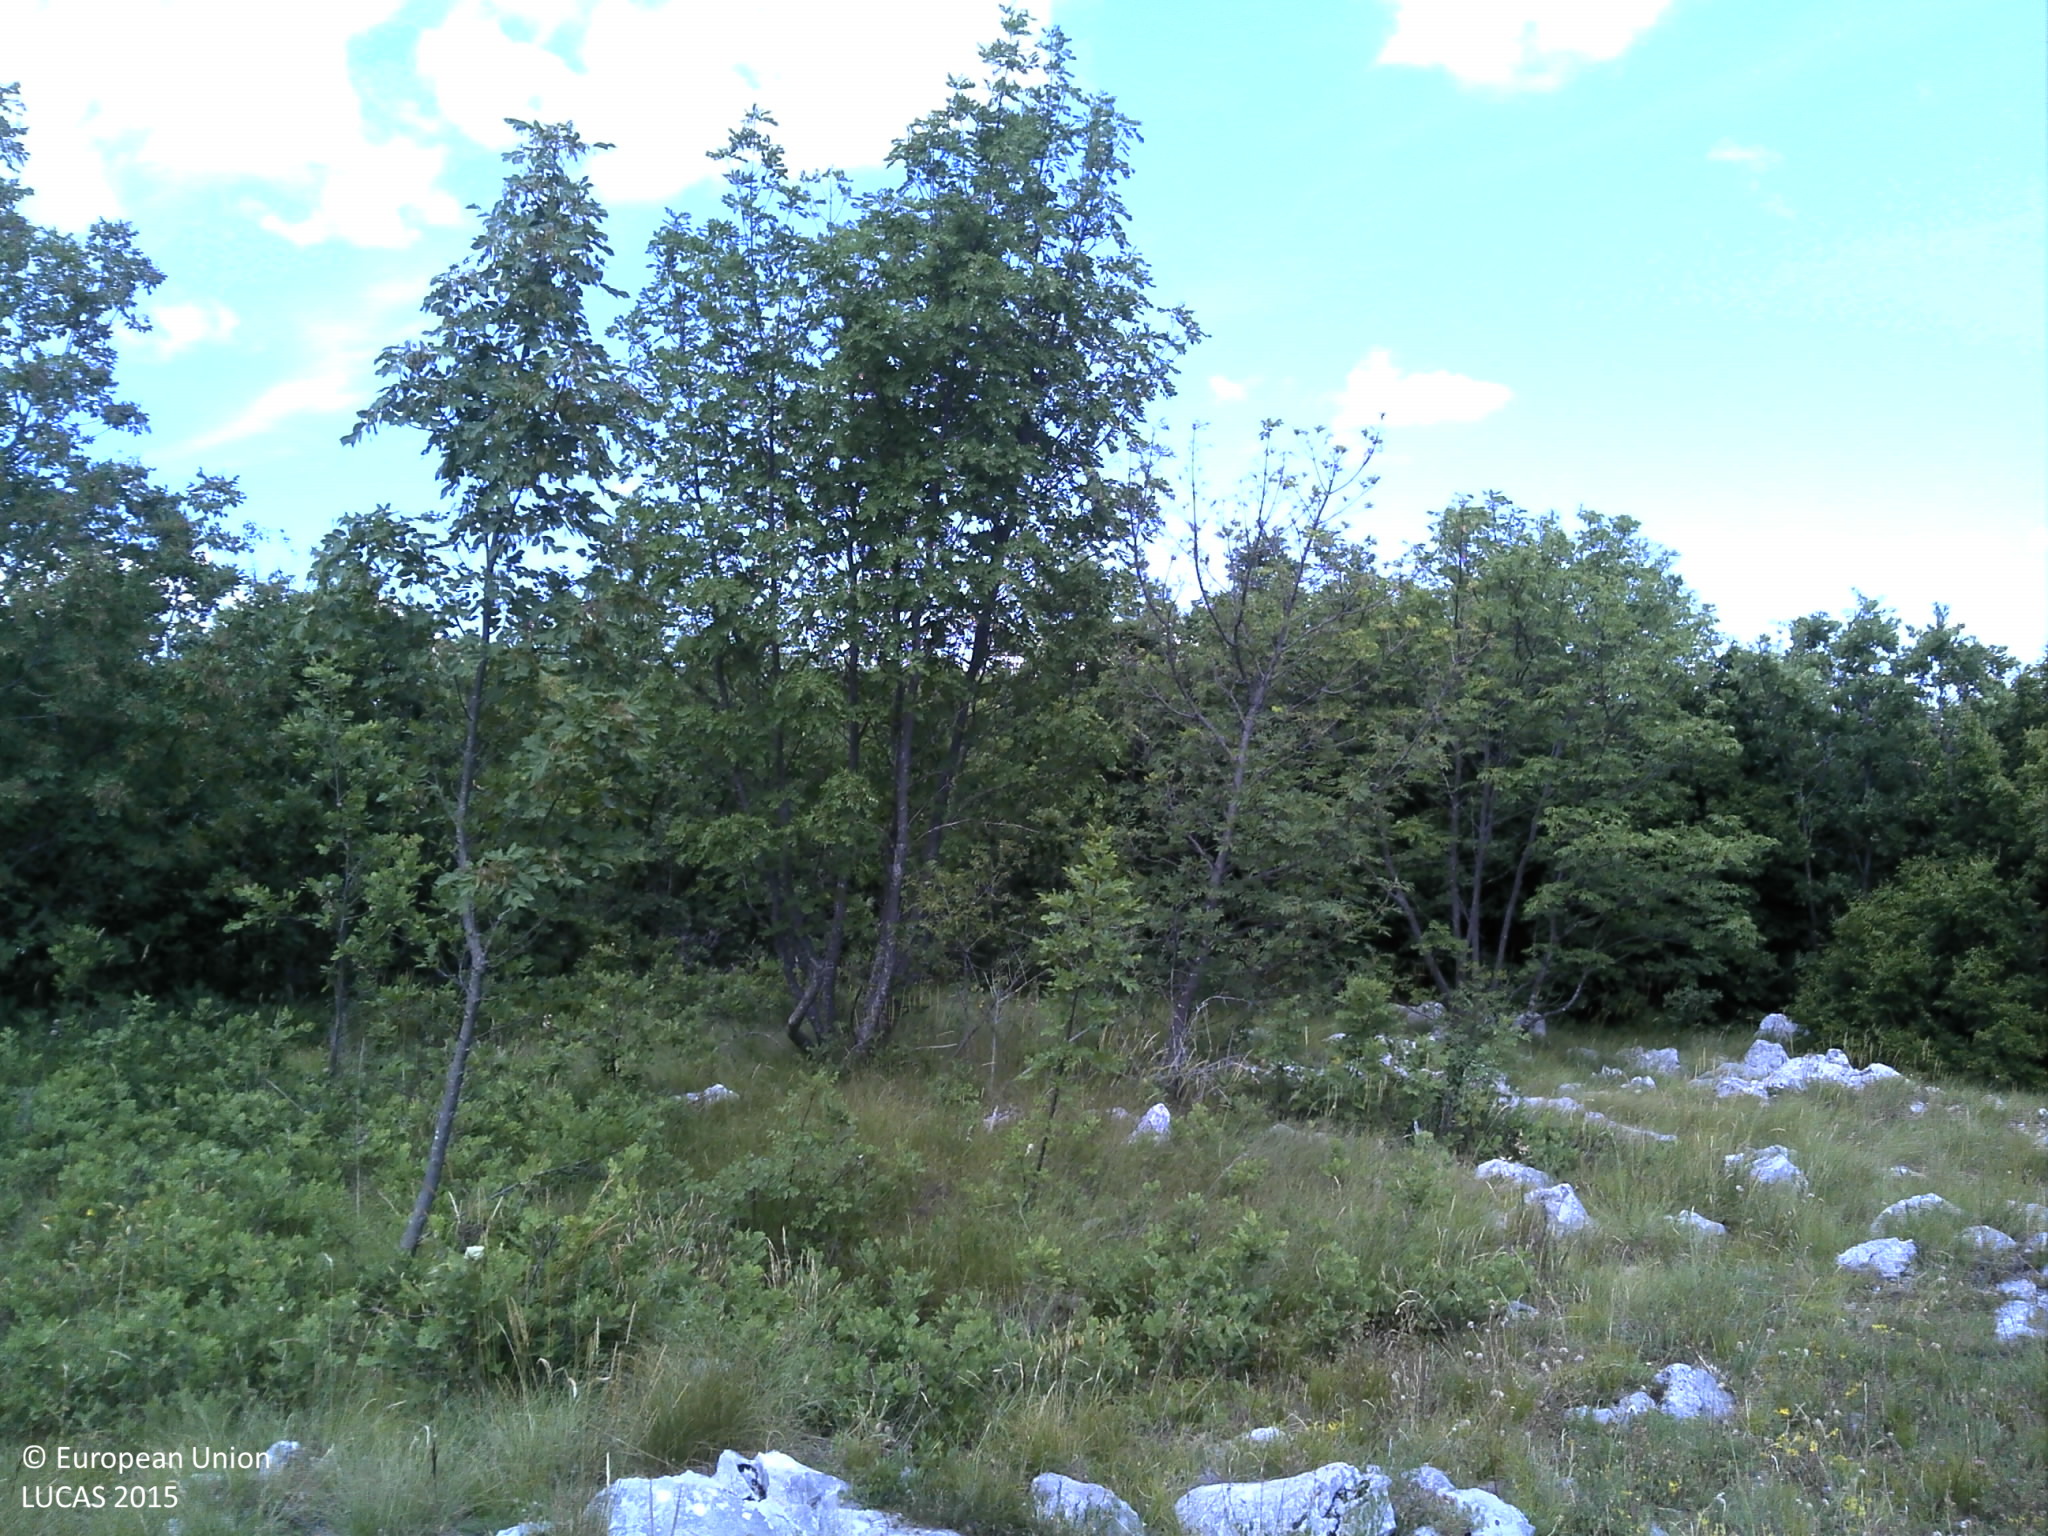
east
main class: Woodland
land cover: Broadleaved woodland
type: thermophilous deciduous forest
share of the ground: 25 - 50 %
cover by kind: broadleaved forest trees 35 %, herbaceous plants 30 %, shrubs 20 %, unconsolidated bare surface 10 %, consolidated bare surface 5 %
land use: Semi-natural and natural areas not in use
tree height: > 5 m
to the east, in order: Broadleaved woodland; Shrubland with sparse tree cover; Broadleaved woodland; Grassland with sparse tree/shrub cover; Shrubland with sparse tree cover; Broadleaved woodland; Grassland with sparse tree/shrub cover
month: June
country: HR
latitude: 43.6110
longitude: 16.9430
